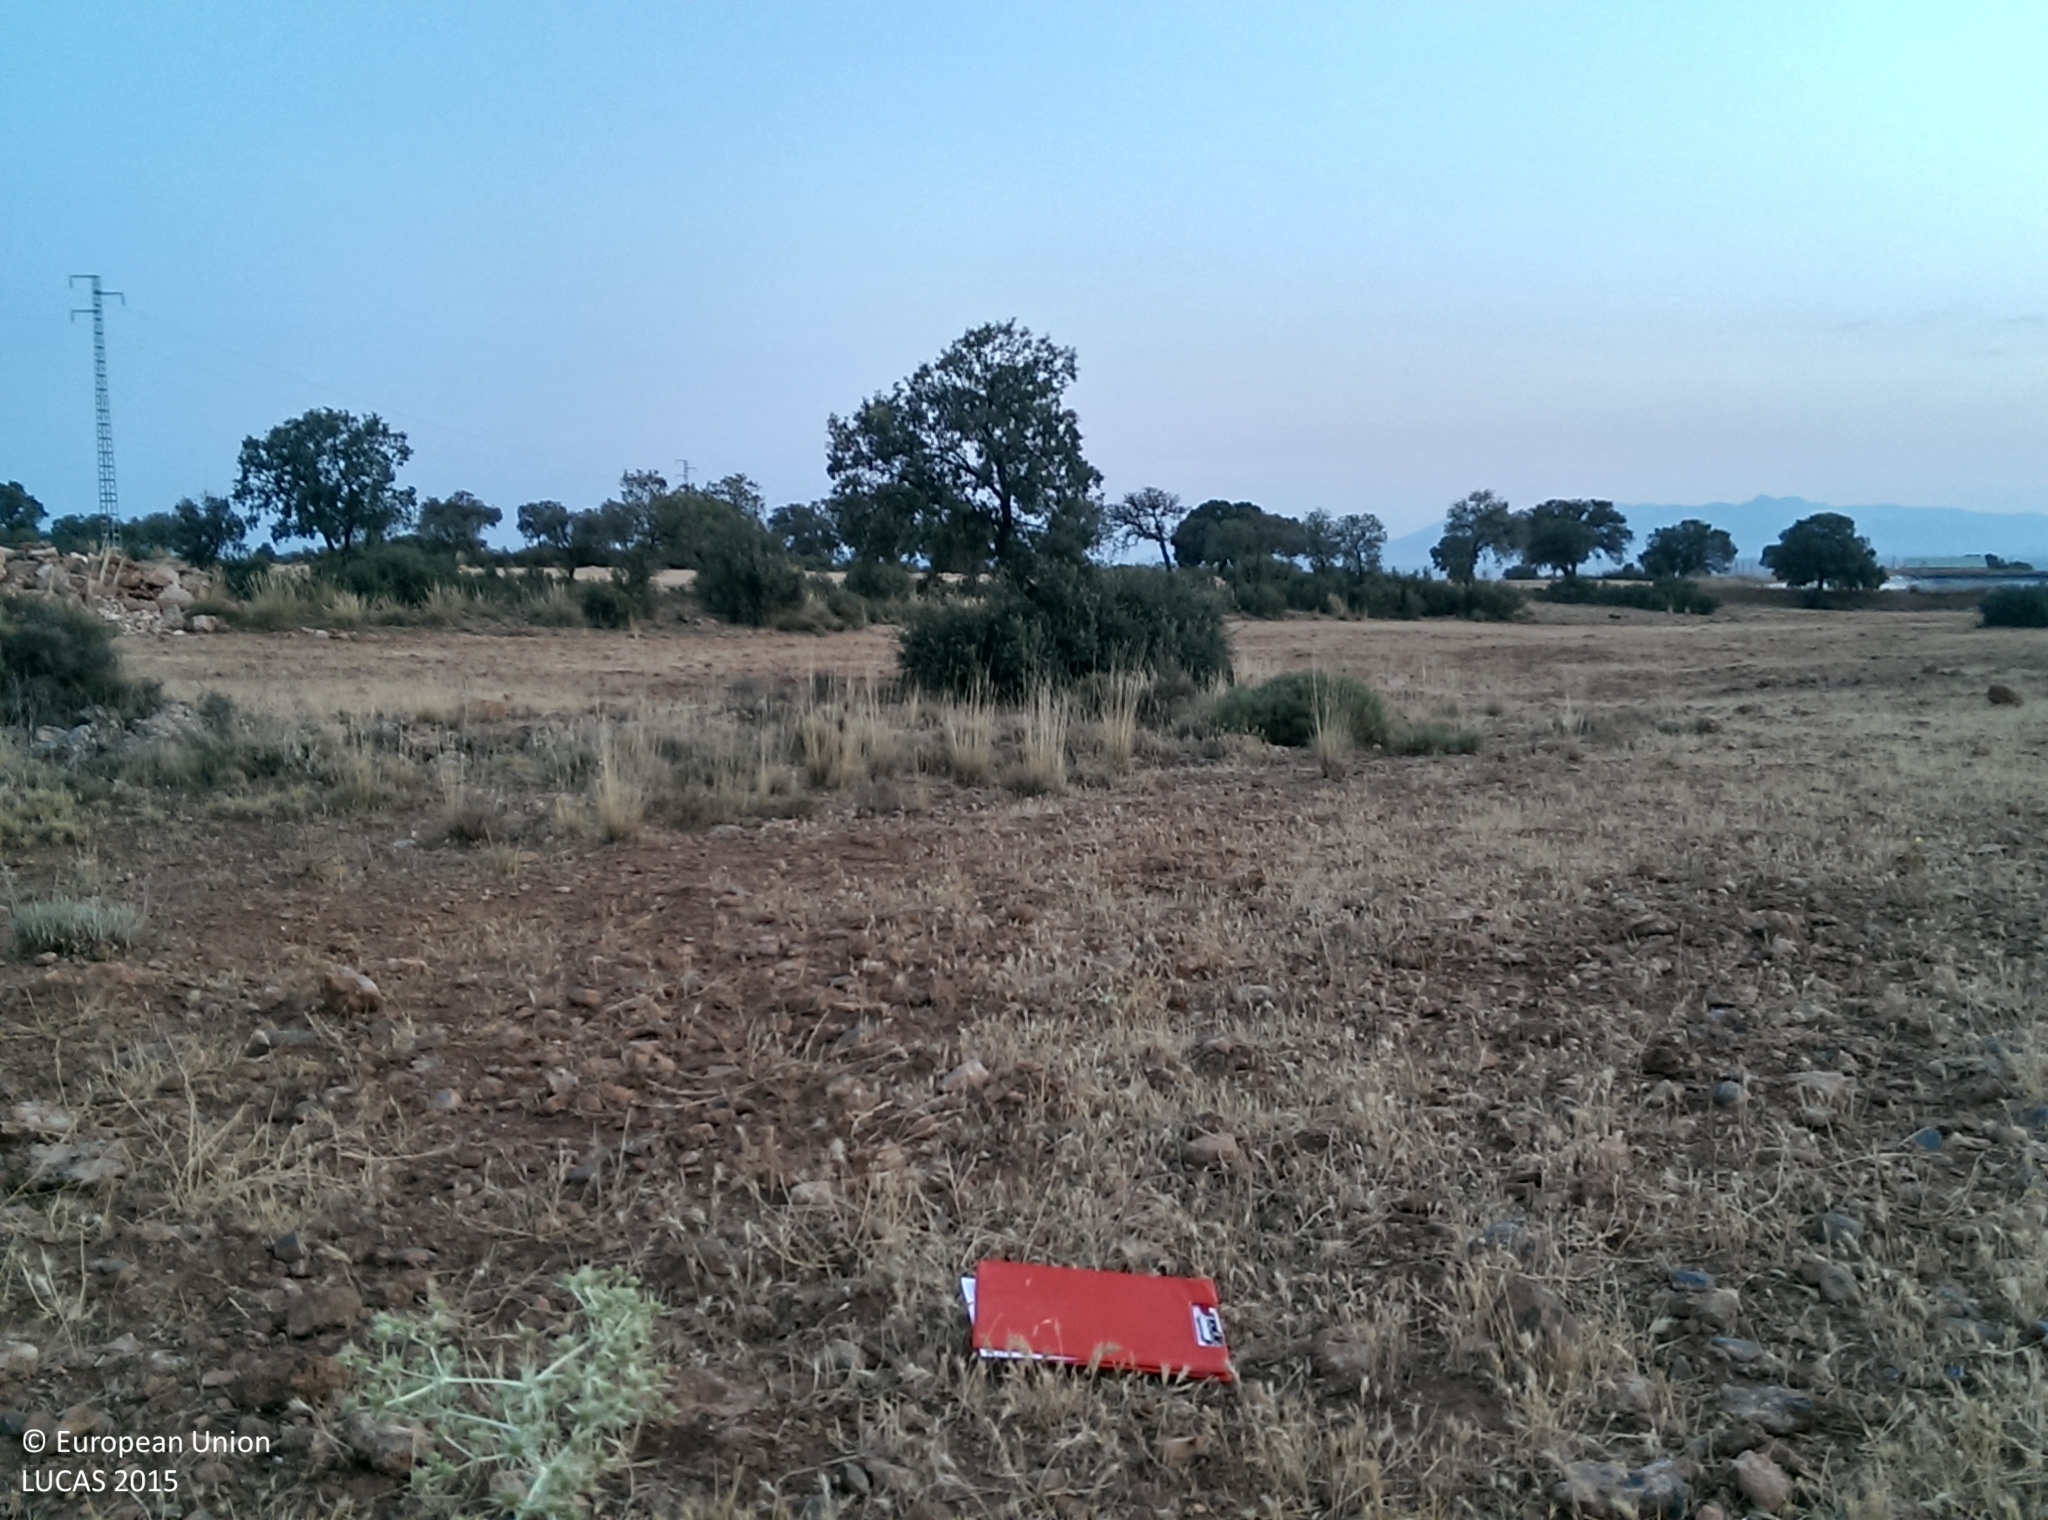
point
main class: Grassland
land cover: Spontaneously vegetated surfaces
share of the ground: 10 - 25 %
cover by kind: unconsolidated bare surface 80 %, herbaceous plants 20 %
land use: Agriculture (excluding fallow land and kitchen gardens)
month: July
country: ES
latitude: 37.4686
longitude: -2.9115
